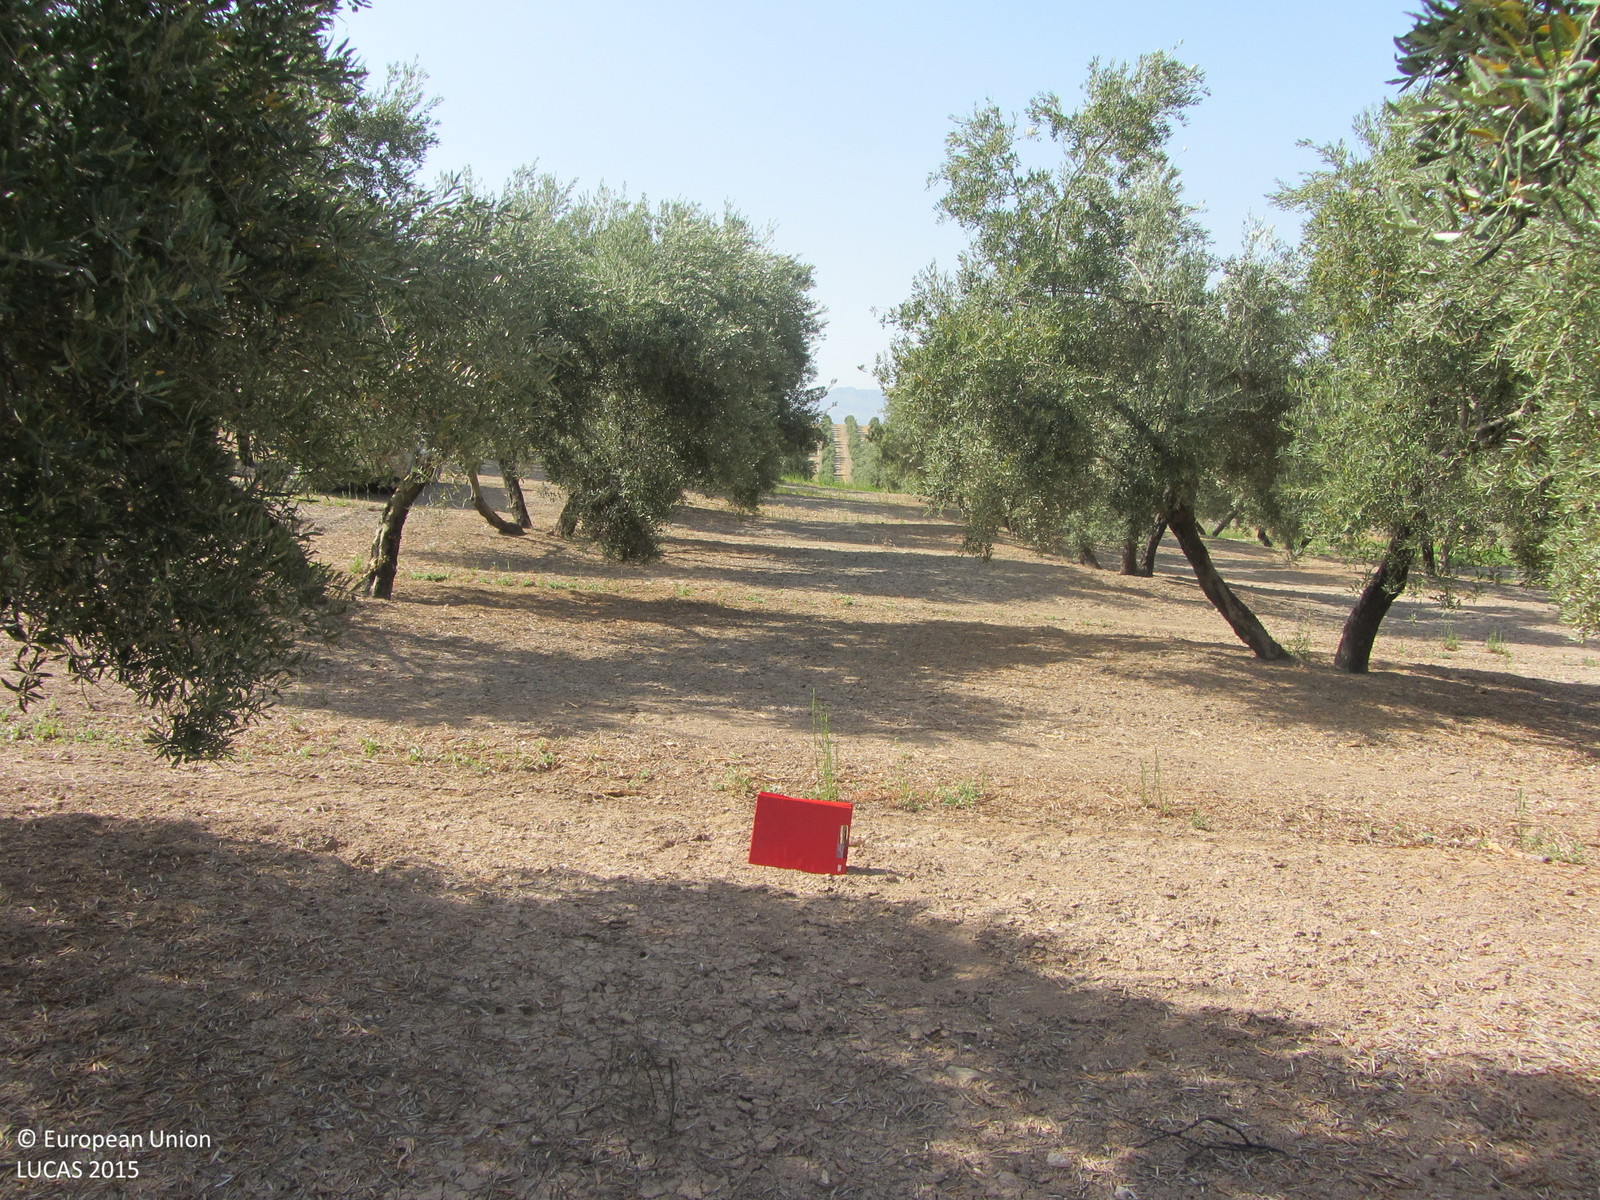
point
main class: Cropland
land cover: Olive groves
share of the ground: 50 - 75 %
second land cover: Other bare soil
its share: > 75 %
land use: Agriculture (excluding fallow land and kitchen gardens)
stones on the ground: < 10 %
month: July
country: ES
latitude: 37.9482
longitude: -3.4165
